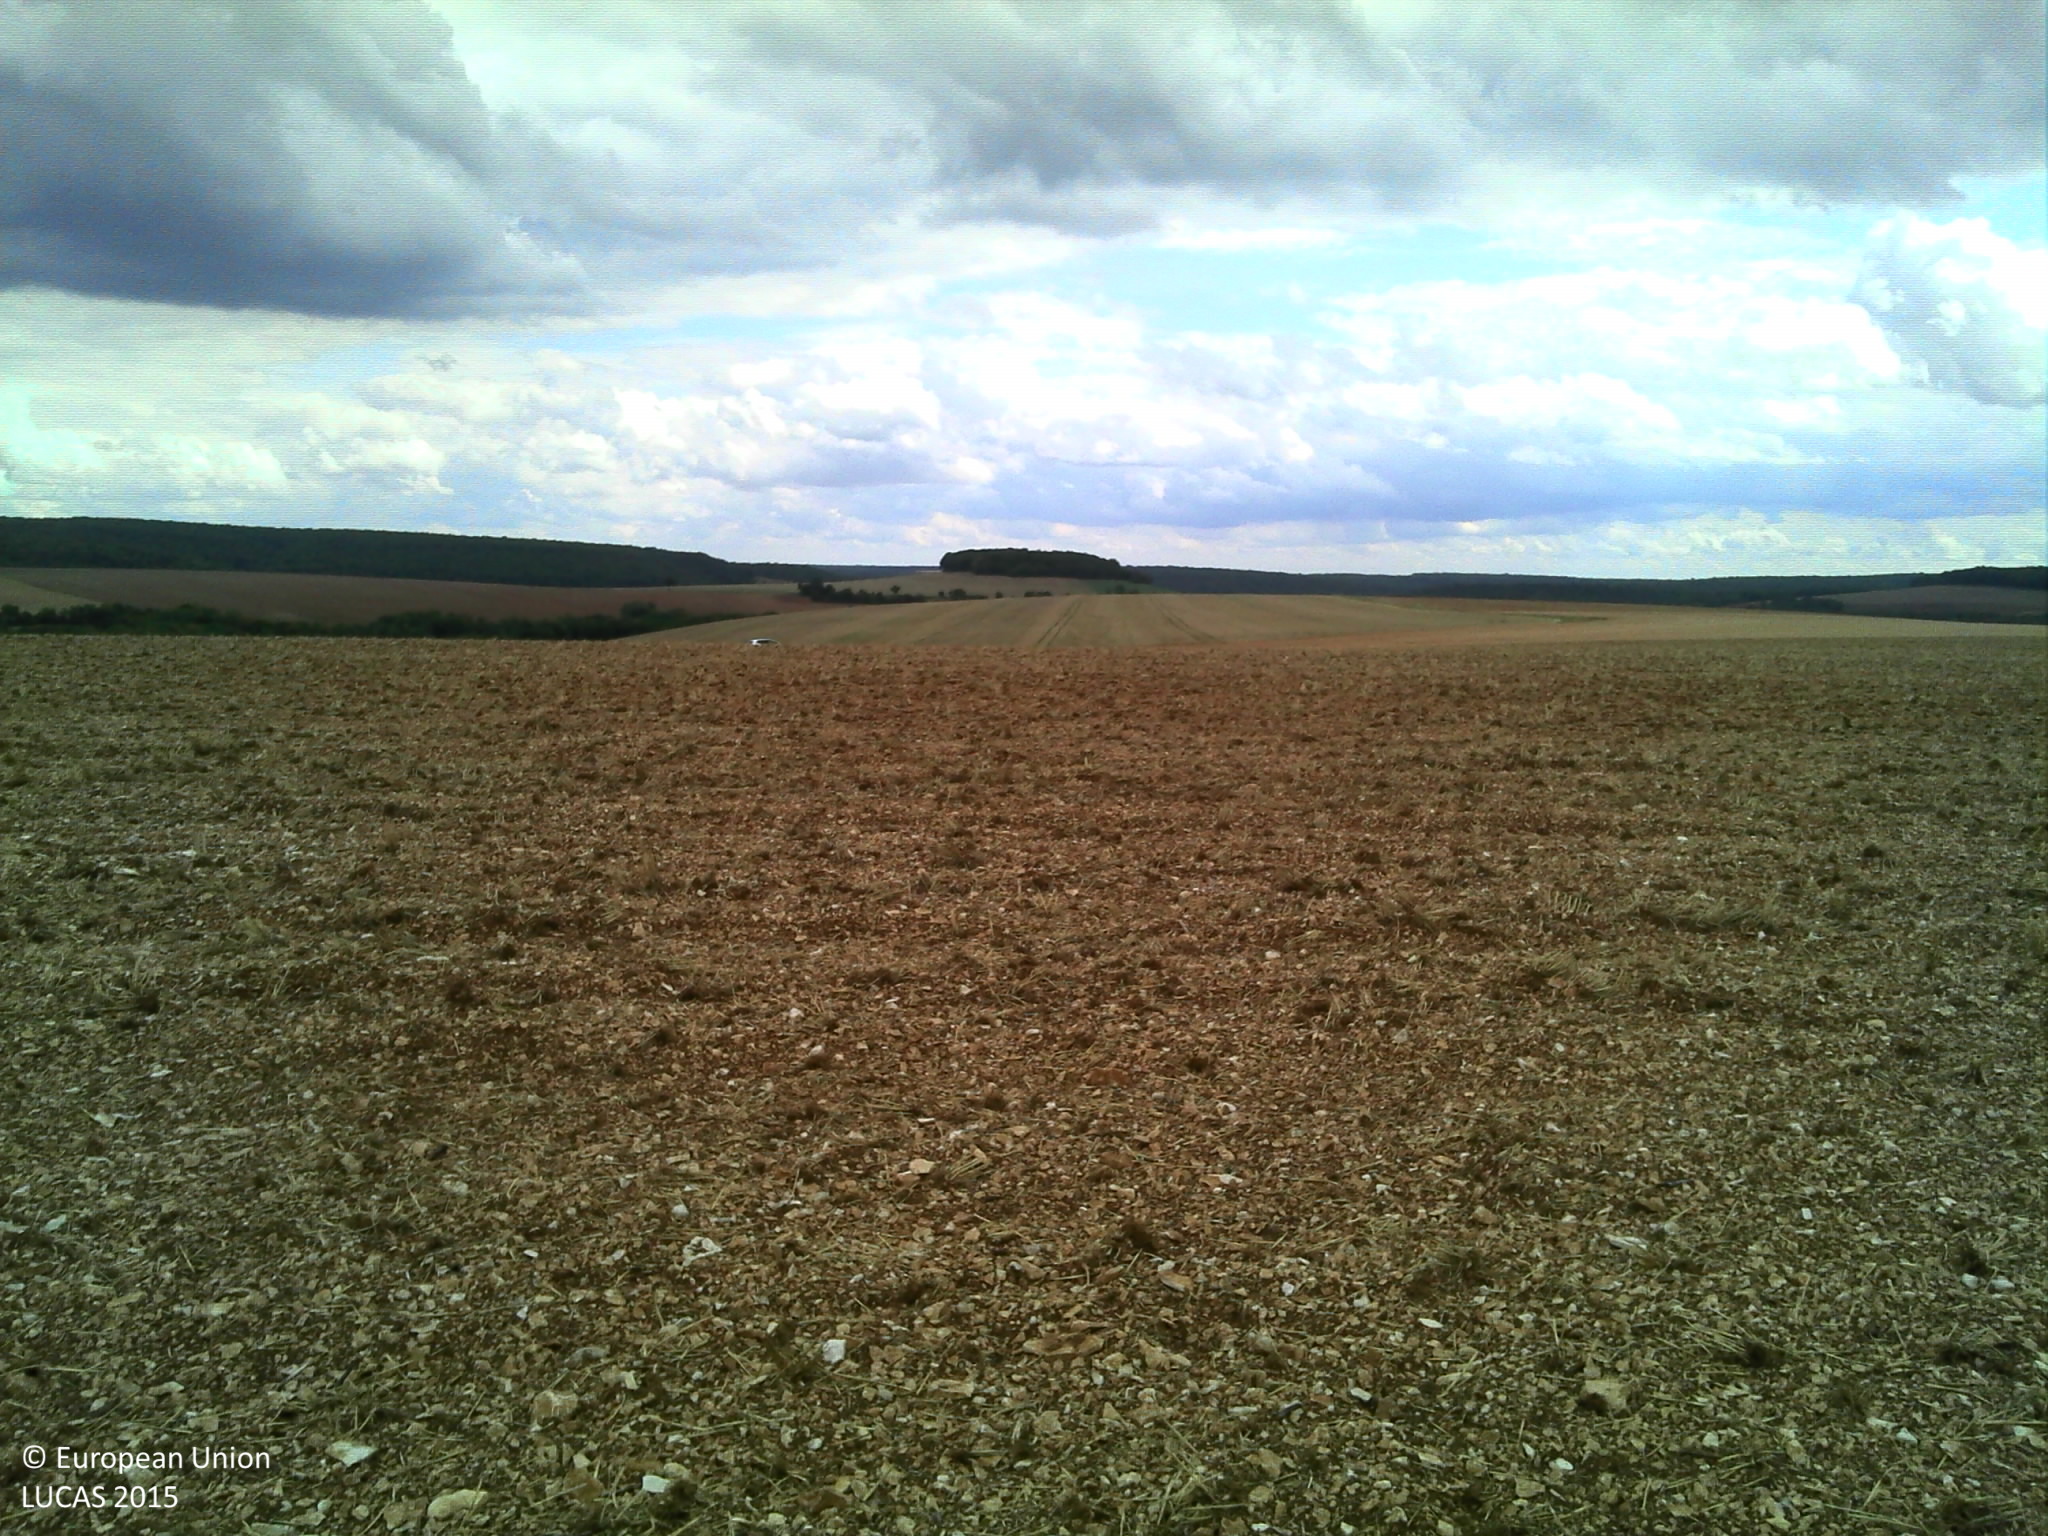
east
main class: Cropland
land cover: Durum wheat
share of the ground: > 75 %
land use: Agriculture (excluding fallow land and kitchen gardens)
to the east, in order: Durum wheat; Grass margins; Tracks; Grass margins; Common wheat
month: September
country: FR
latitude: 47.6201
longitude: 4.9303
